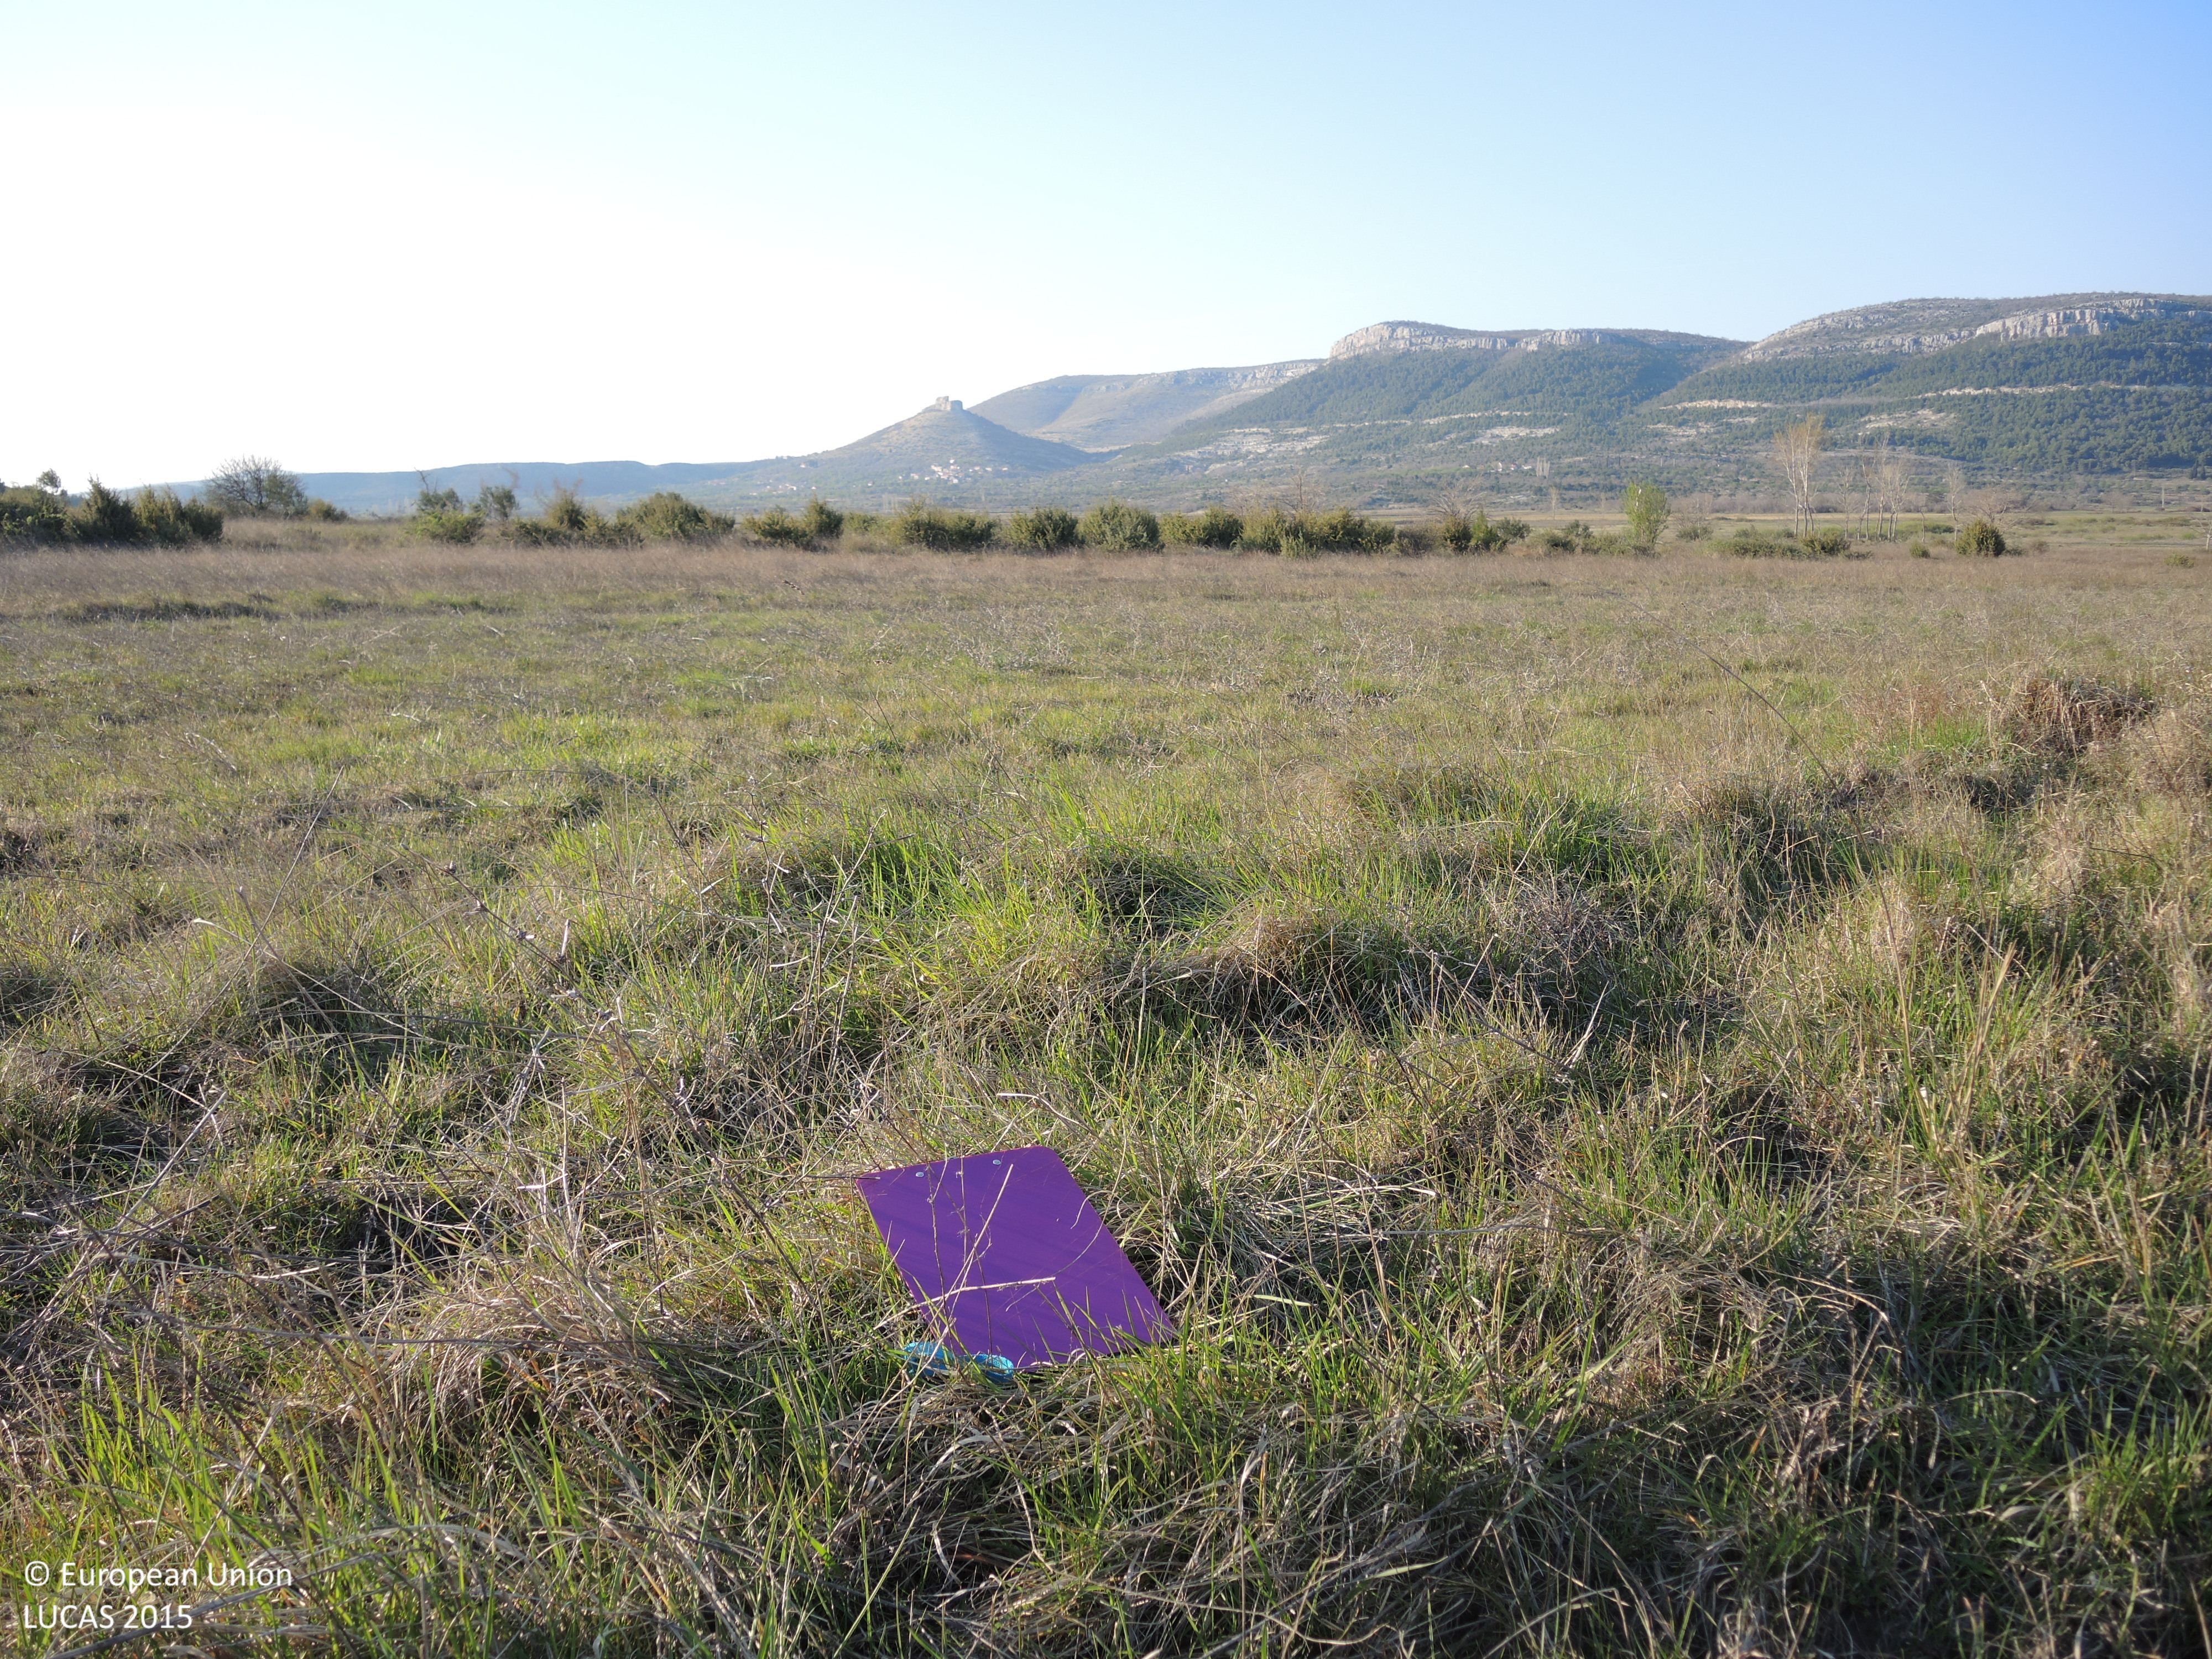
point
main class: Grassland
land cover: Grassland with sparse tree/shrub cover
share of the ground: > 75 %
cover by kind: herbaceous plants 80 %, shrubs 10 %, broadleaved forest trees 5 %, unconsolidated bare surface 5 %
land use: Abandoned areas
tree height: < 5 m
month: April
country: HR
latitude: 43.9347
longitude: 15.8092
